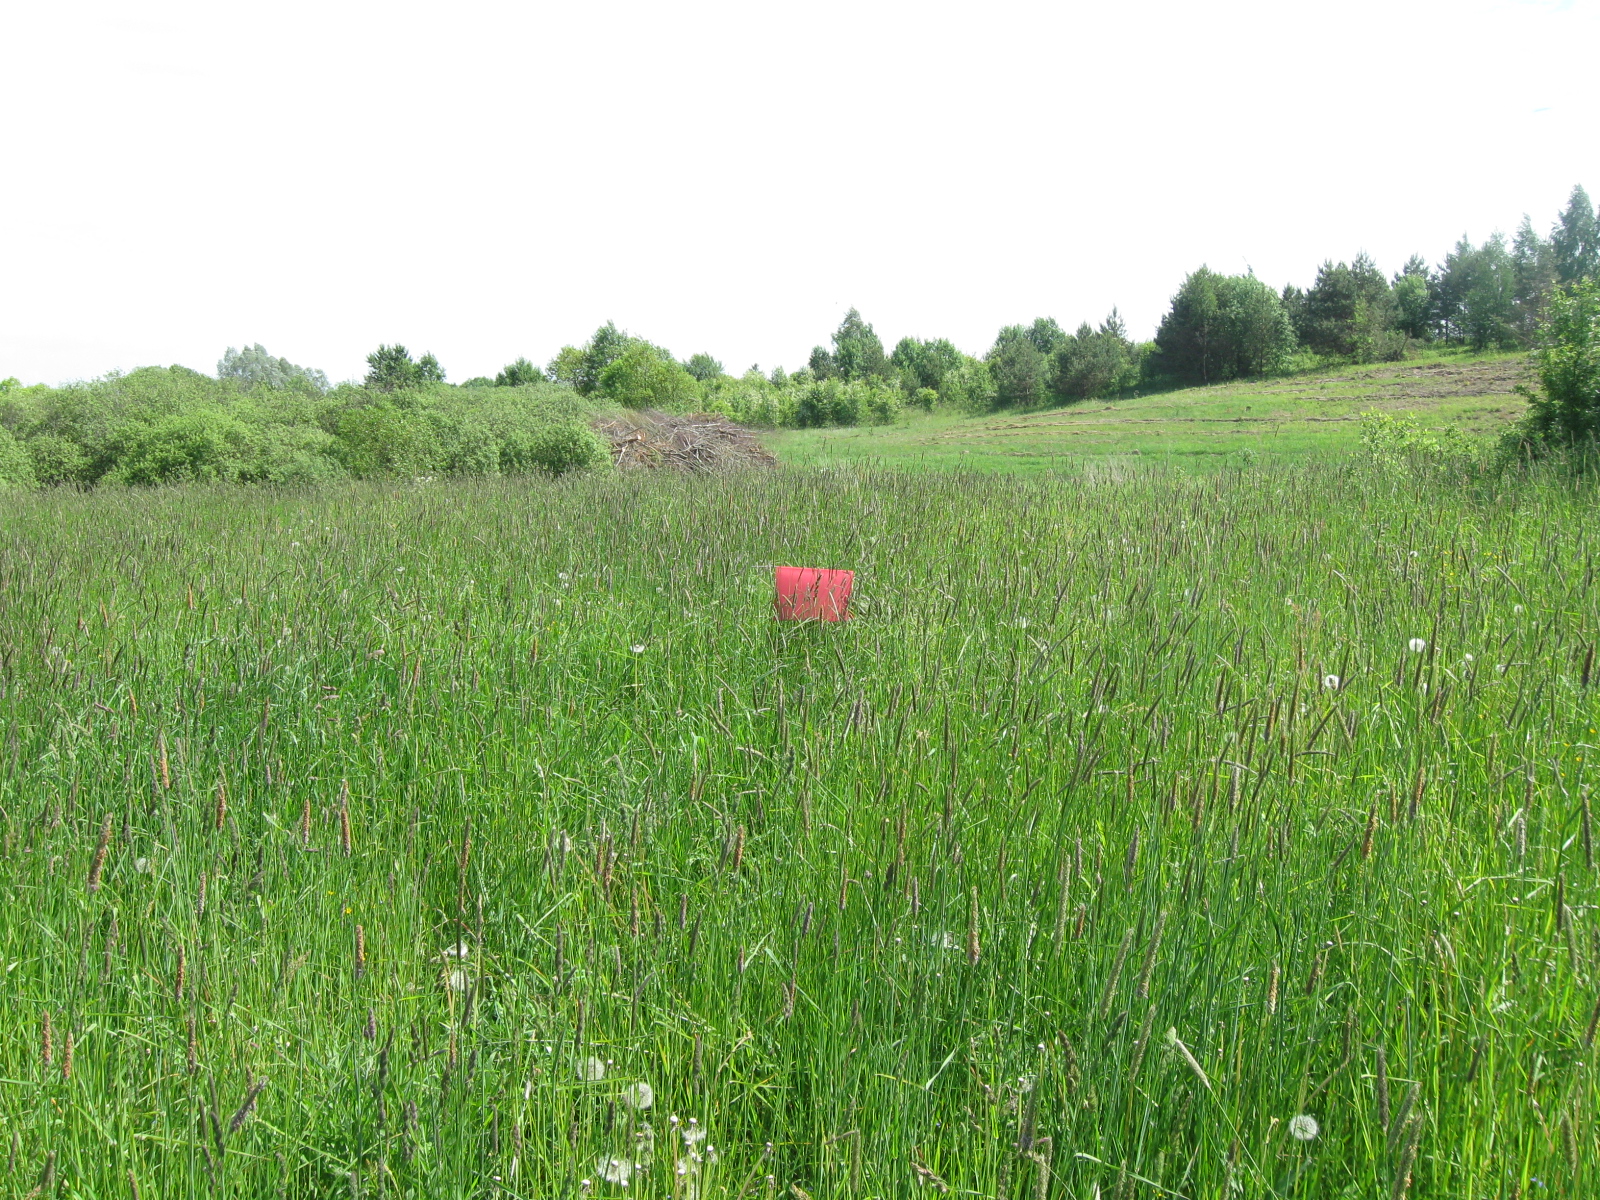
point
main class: Grassland
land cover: Grassland without tree/shrub cover
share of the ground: > 75 %
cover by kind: herbaceous plants 100 %
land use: Agriculture (excluding fallow land and kitchen gardens)
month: June
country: LT
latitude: 54.2330
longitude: 23.7882
